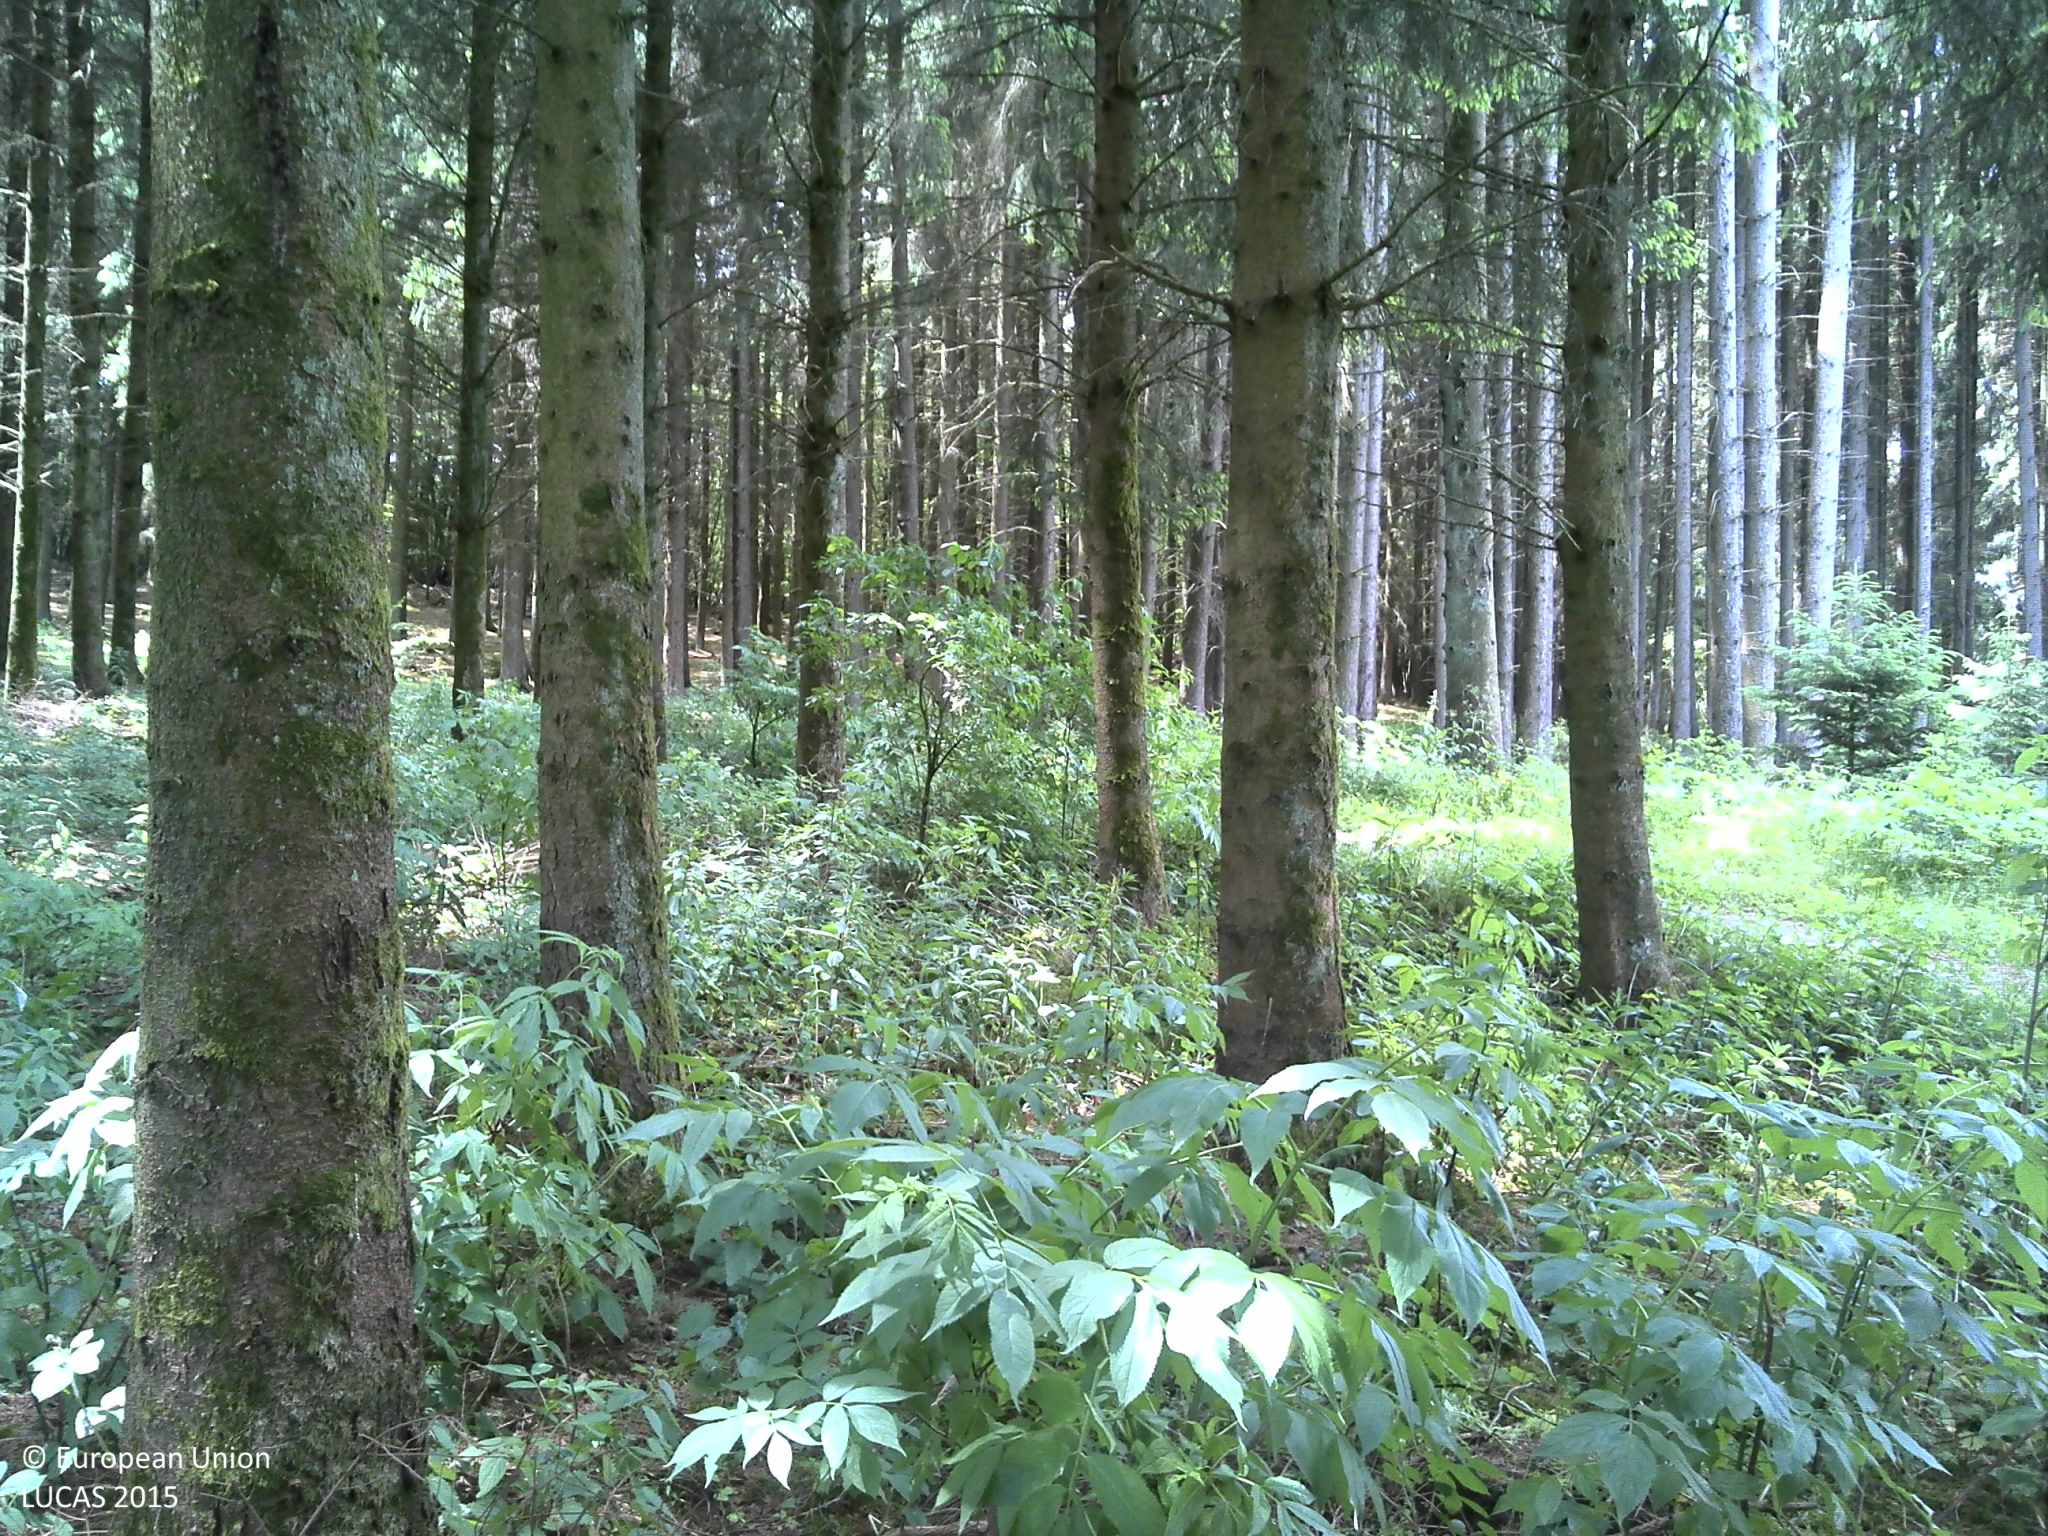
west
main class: Woodland
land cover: Spruce dominated coniferous woodland
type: exotic forest
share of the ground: > 75 %
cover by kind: coniferous forest trees 75 %, herbaceous plants 10 %, lichens and mosses 10 %, consolidated bare surface 5 %
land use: Forestry
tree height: > 5 m
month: June
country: LU
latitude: 50.0039
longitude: 5.9389
